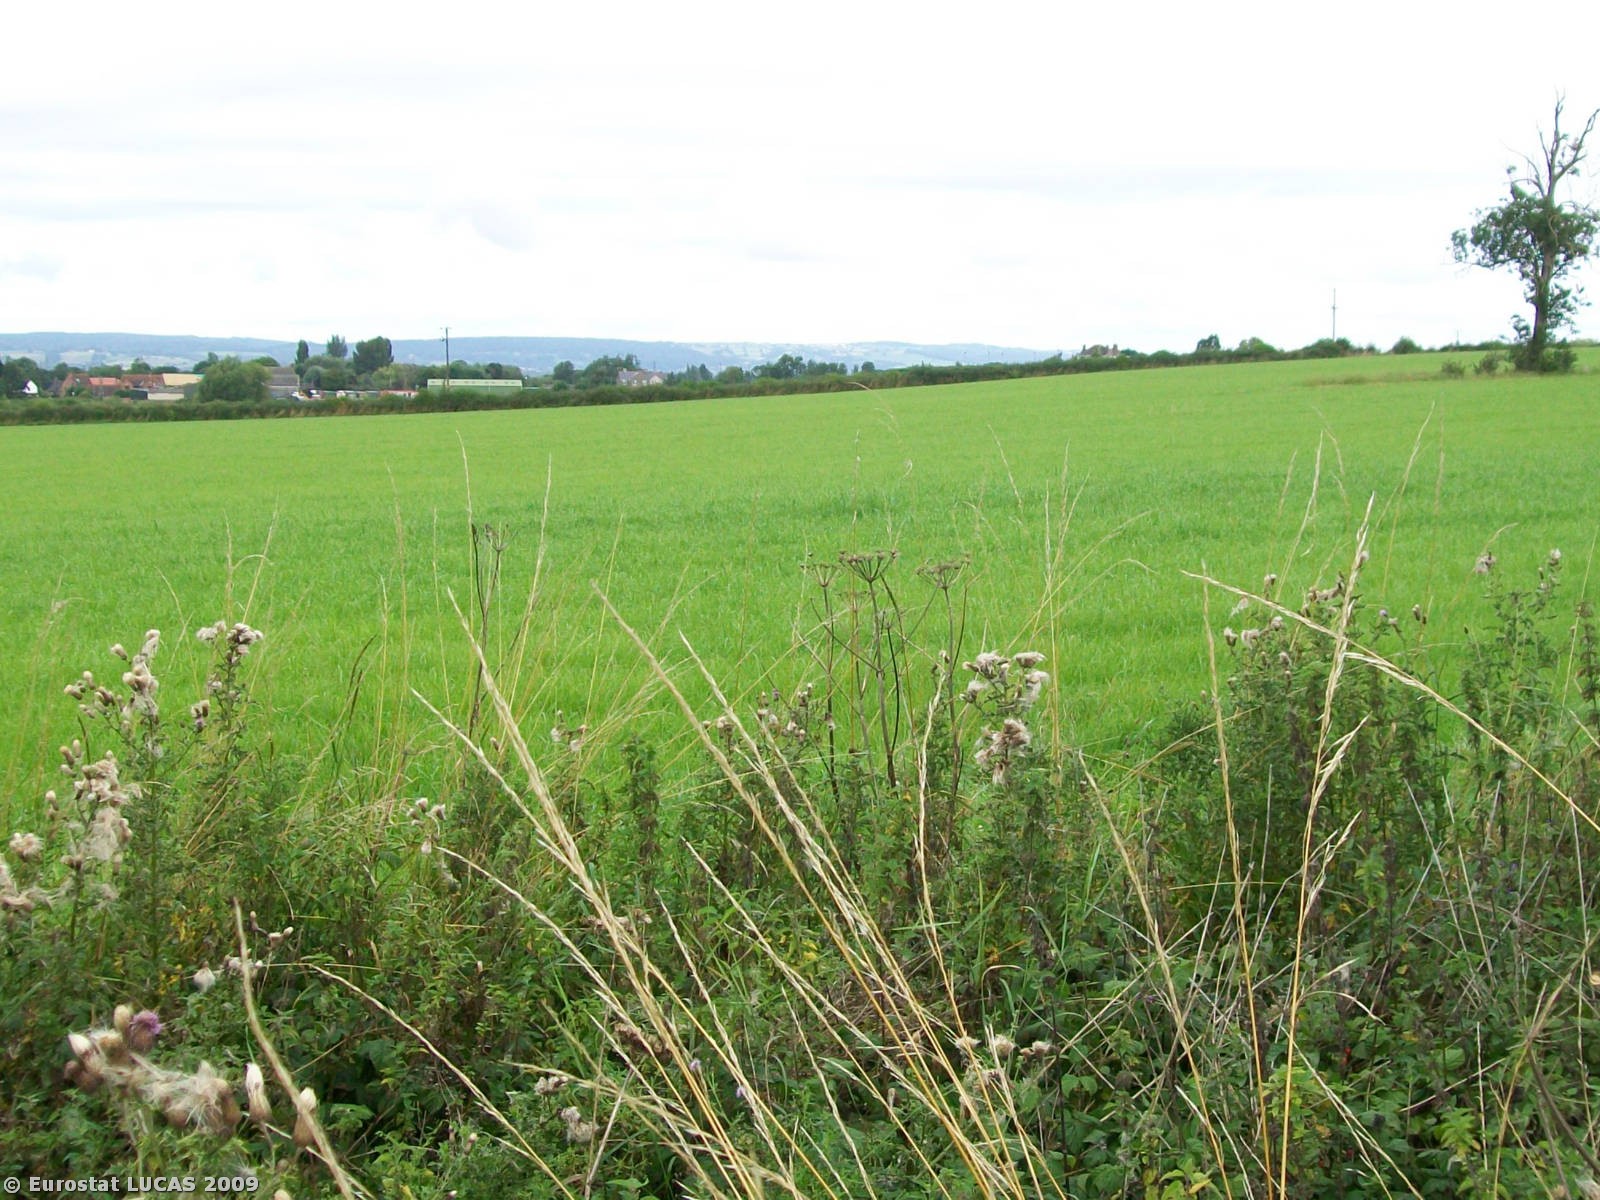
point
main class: Cropland
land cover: Temporary grasslands
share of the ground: > 75 %
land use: Agriculture (excluding fallow land and kitchen gardens)
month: August
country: GB
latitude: 51.7289
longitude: -2.3562
